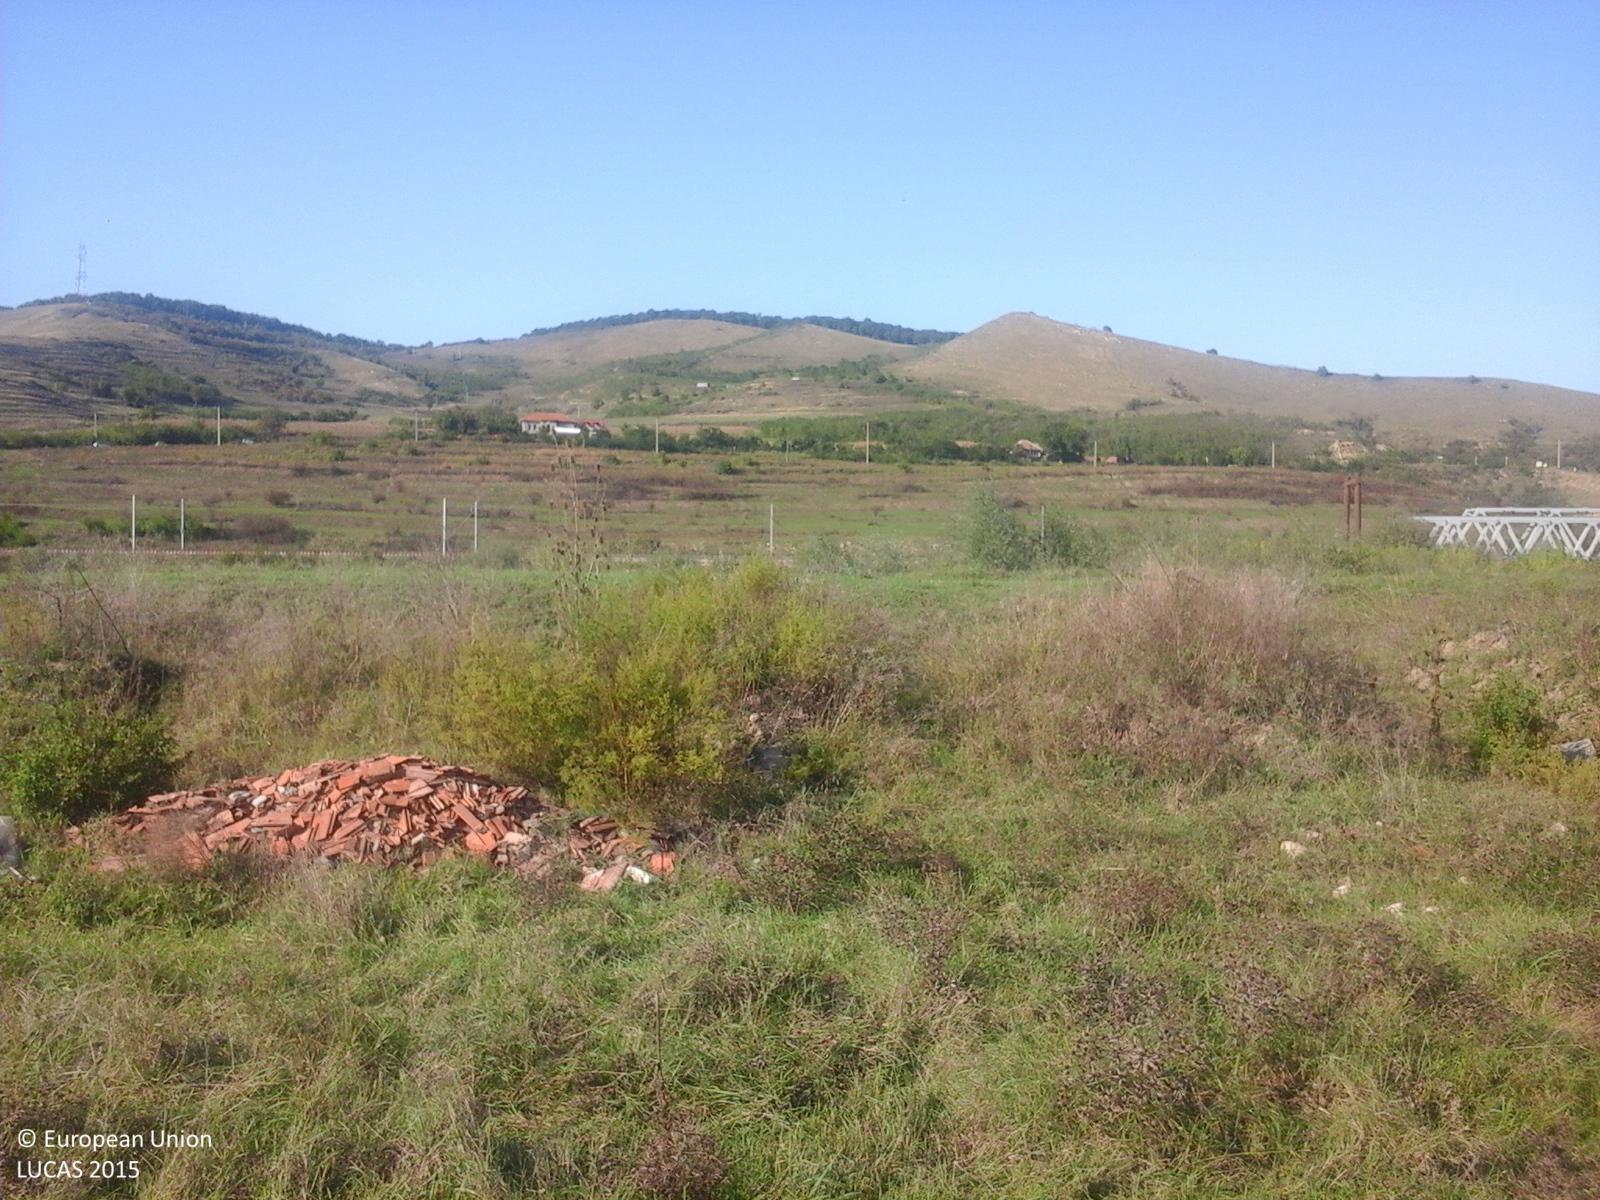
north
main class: Grassland
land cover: Grassland without tree/shrub cover
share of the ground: > 75 %
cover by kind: herbaceous plants 100 %
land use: Agriculture (excluding fallow land and kitchen gardens)
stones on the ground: < 10 %
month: October
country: RO
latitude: 46.1699
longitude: 23.8926
